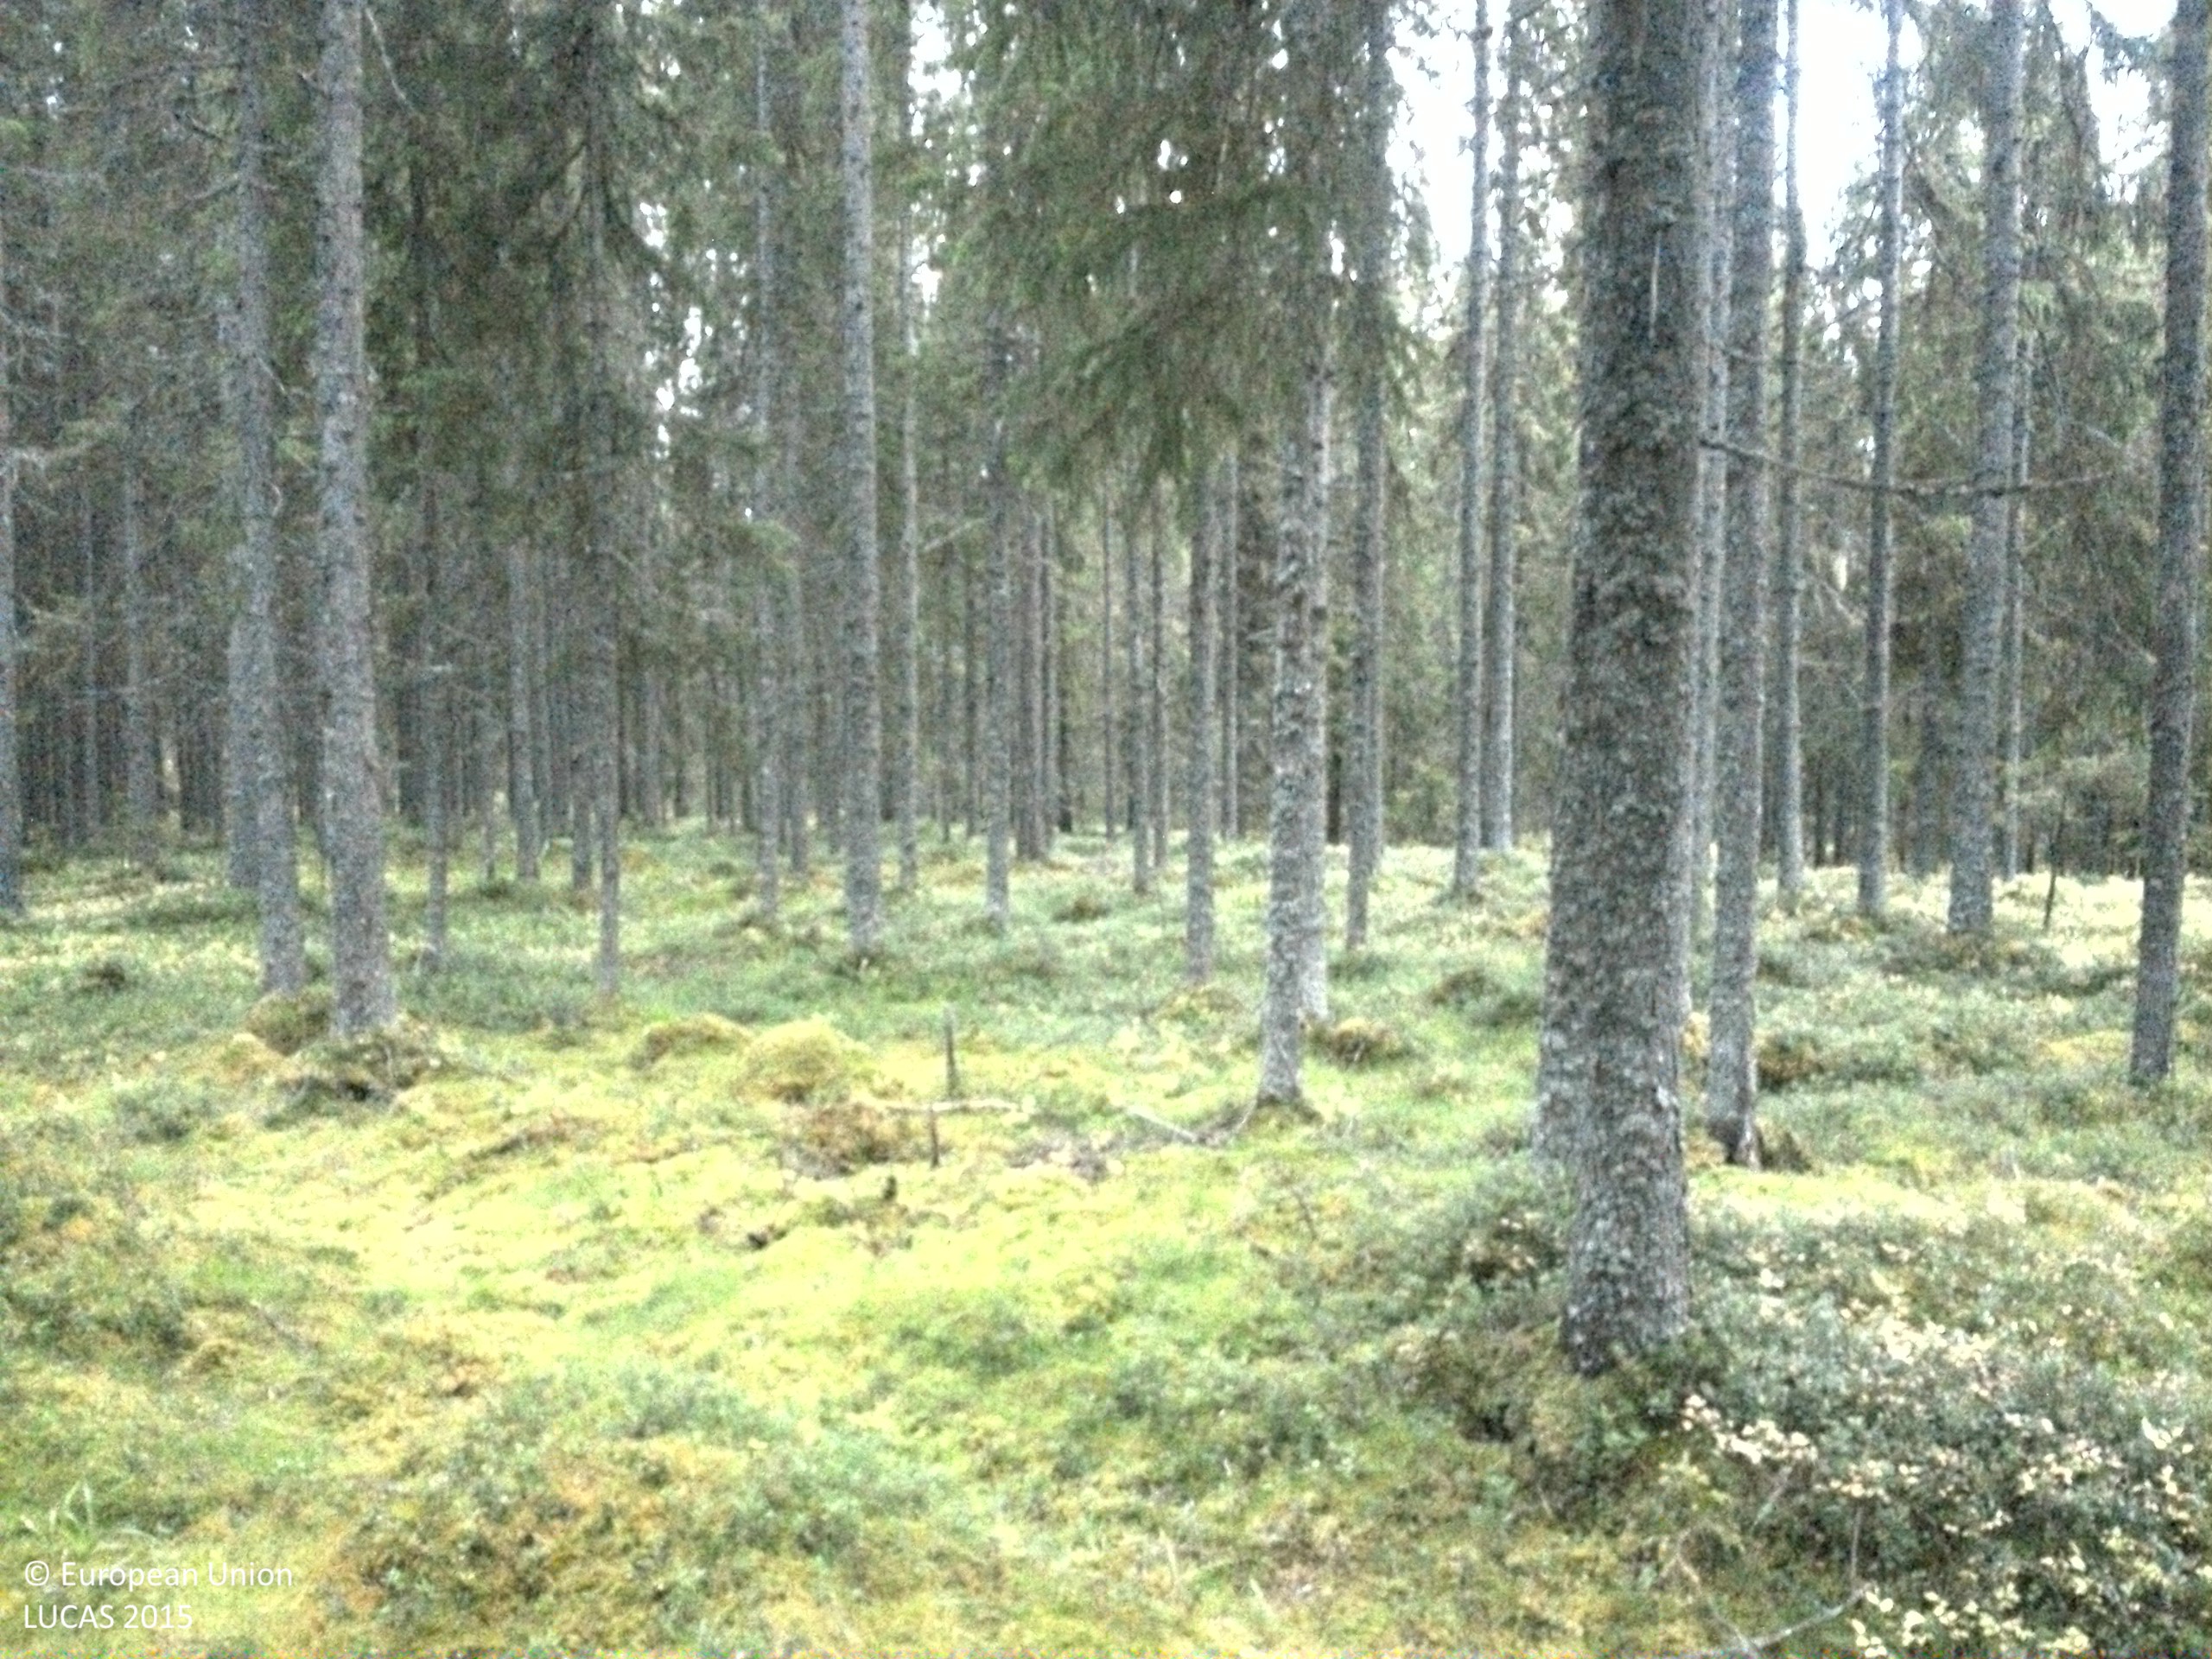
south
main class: Woodland
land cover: Spruce dominated coniferous woodland
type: boreal forest
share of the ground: 50 - 75 %
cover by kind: coniferous forest trees 50 %, shrubs 30 %, lichens and mosses 20 %
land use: Forestry
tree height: > 5 m
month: October
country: SE
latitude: 64.2915
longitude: 15.8175
